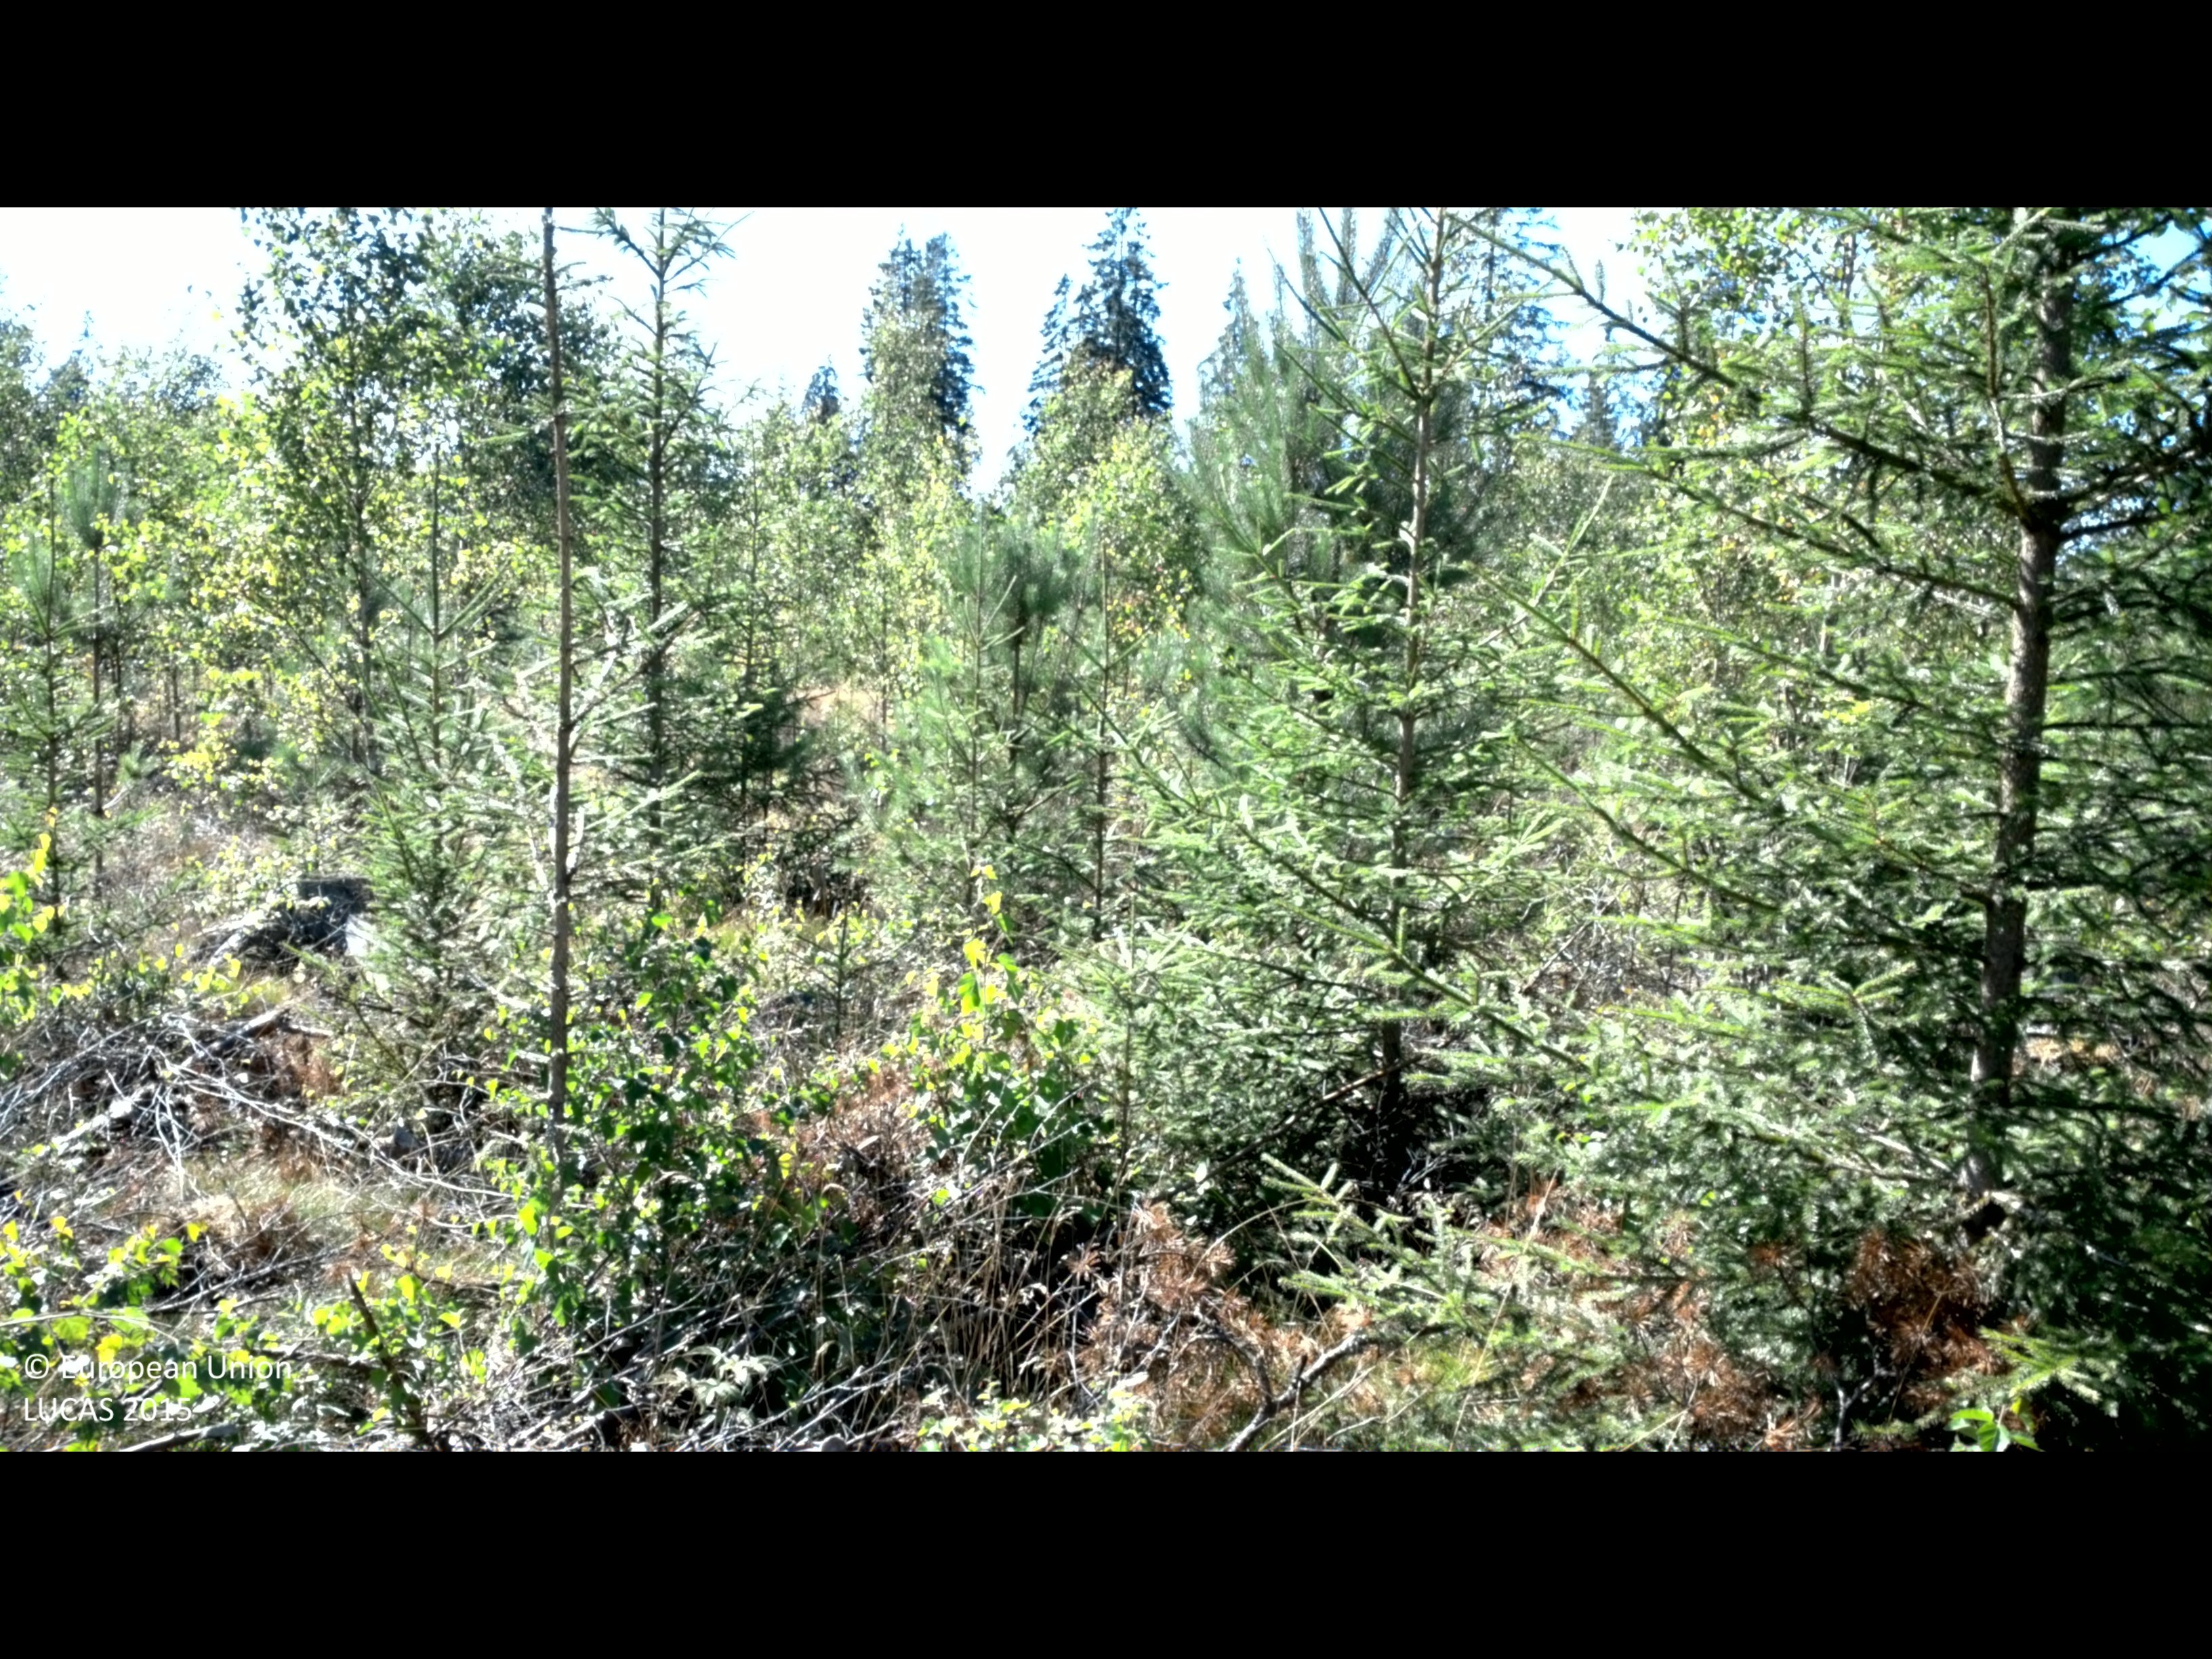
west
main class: Woodland
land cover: Spruce dominated mixed woodland
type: boreal forest
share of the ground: 50 - 75 %
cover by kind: coniferous forest trees 30 %, broadleaved forest trees 30 %, herbaceous plants 30 %, shrubs 10 %
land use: Forestry
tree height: < 5 m
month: August
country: SE
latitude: 56.7260
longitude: 14.3605
